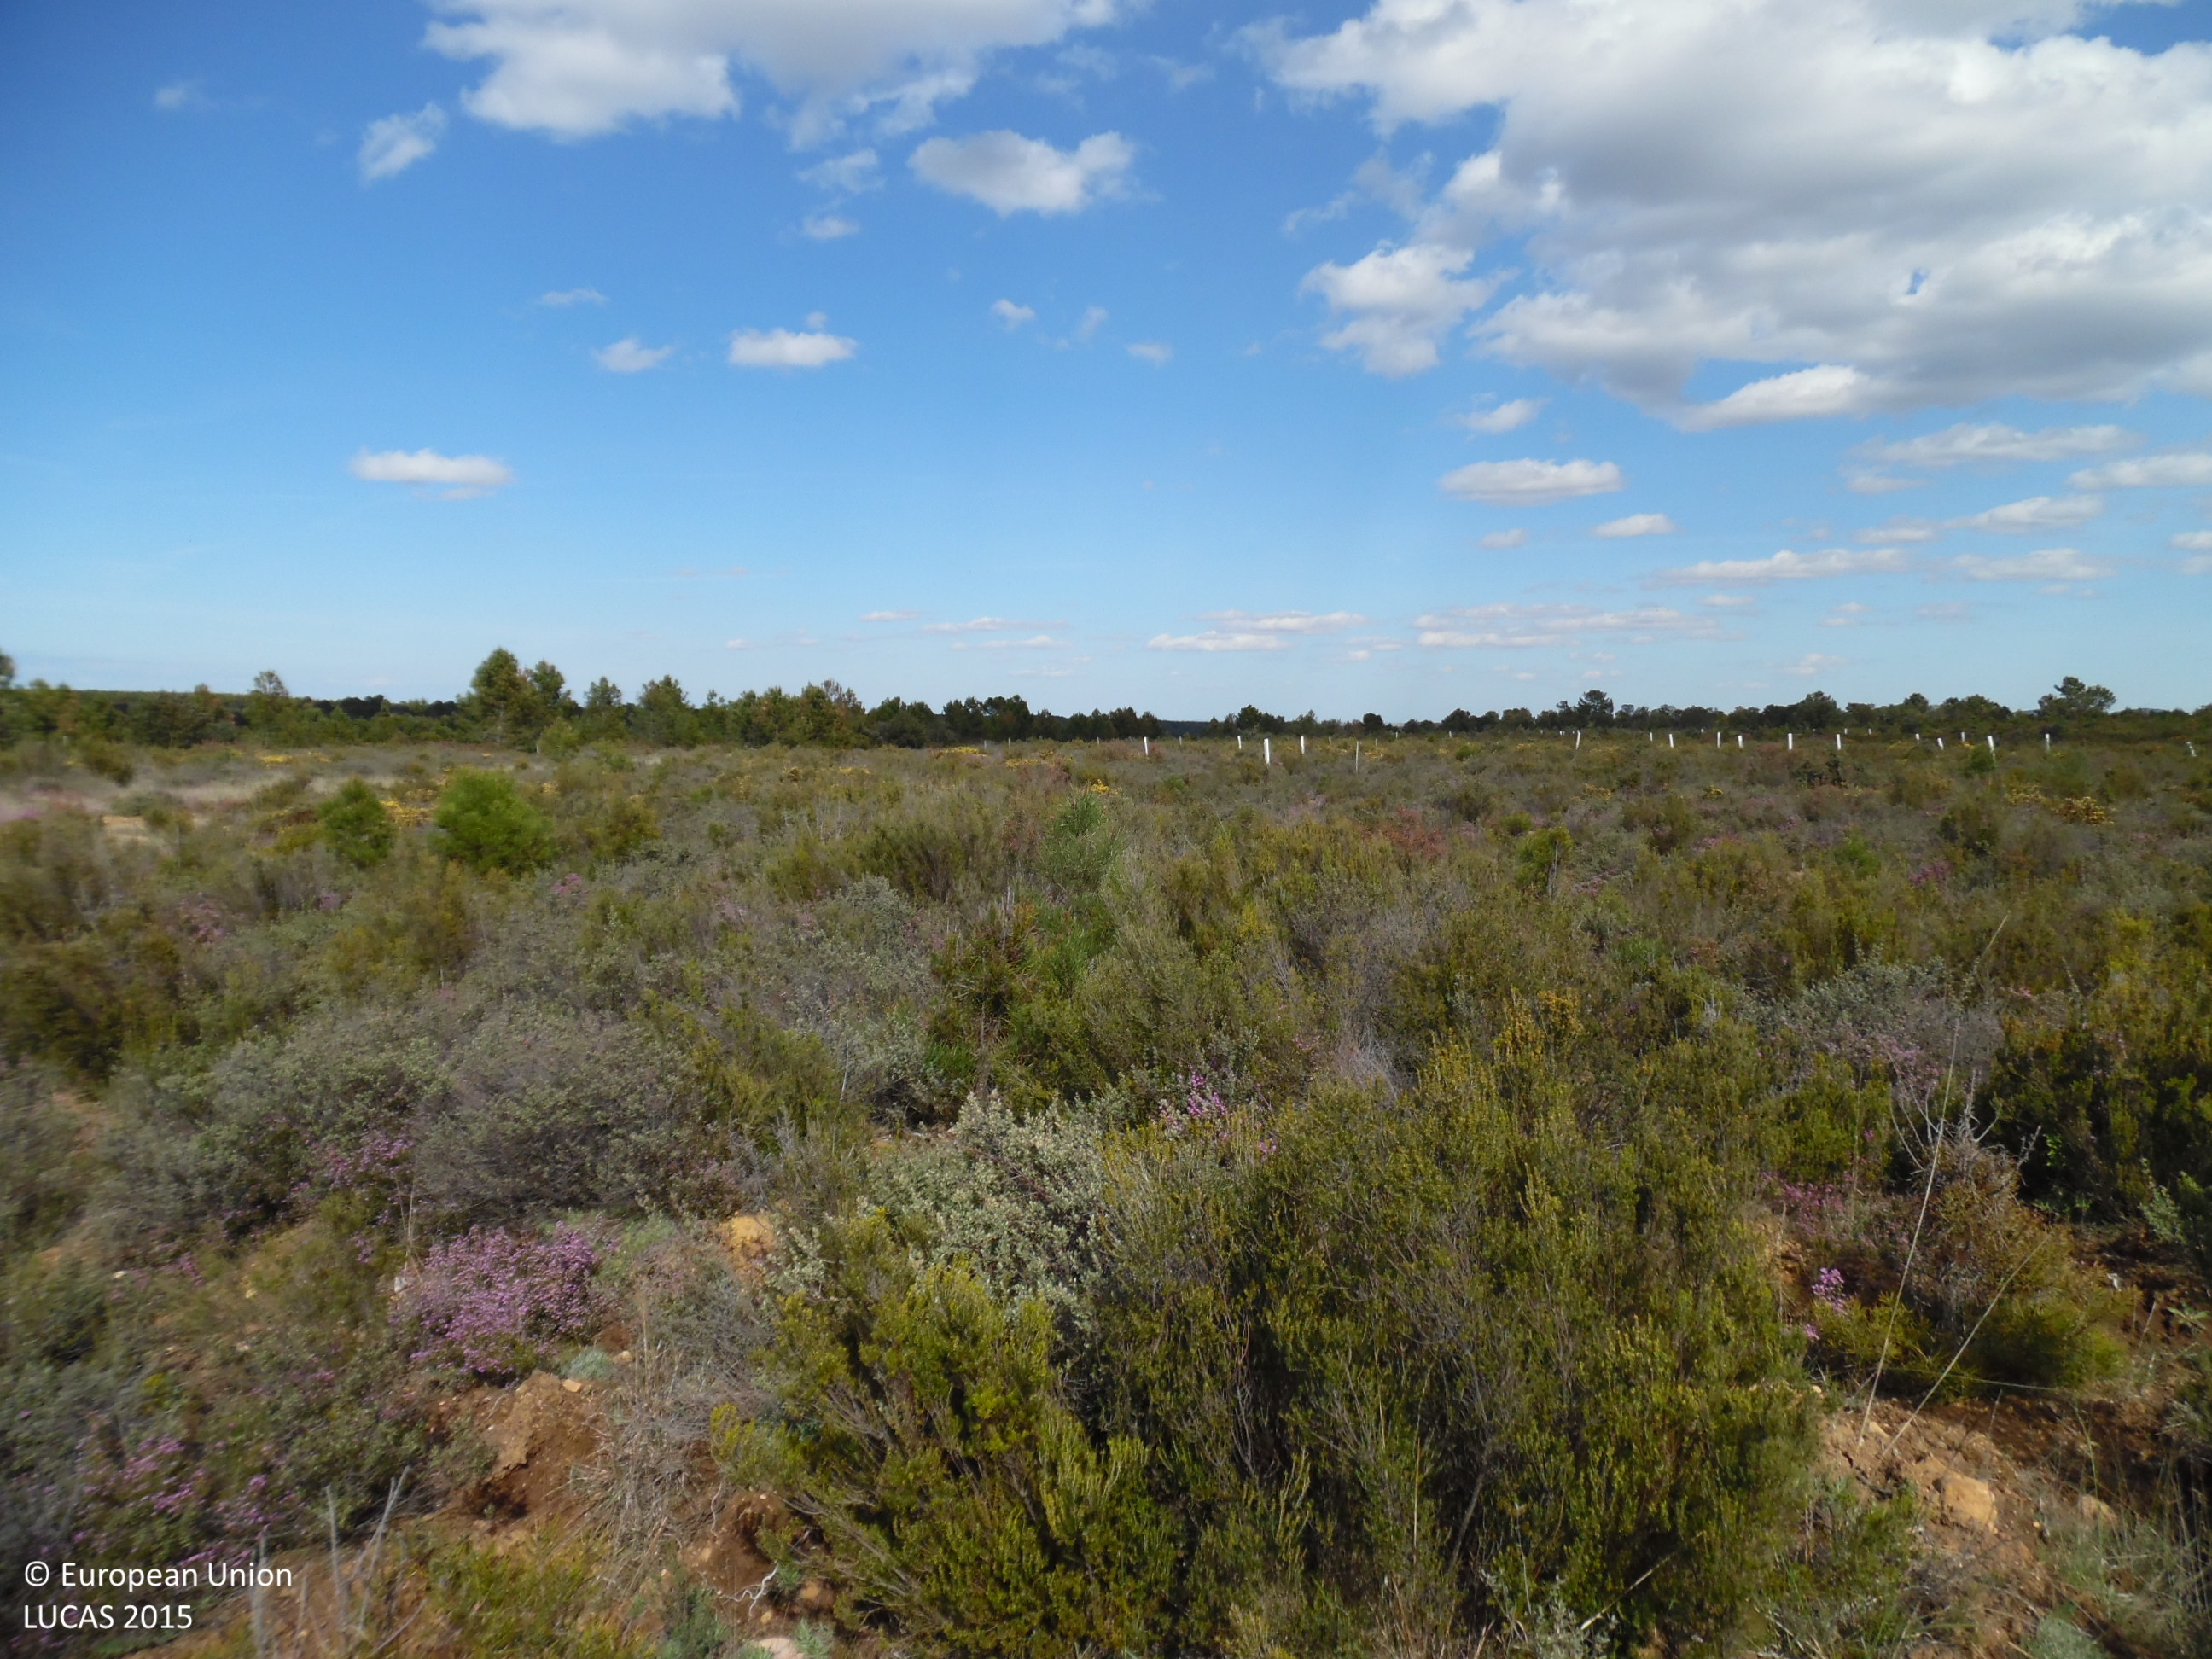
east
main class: Shrubland
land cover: Shrubland with sparse tree cover
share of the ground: > 75 %
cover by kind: shrubs 95 %, coniferous forest trees 5 %
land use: Forestry
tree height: < 5 m
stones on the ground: < 10 %
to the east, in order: Shrubland with sparse tree cover
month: April
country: ES
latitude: 42.2755
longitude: -6.0976
